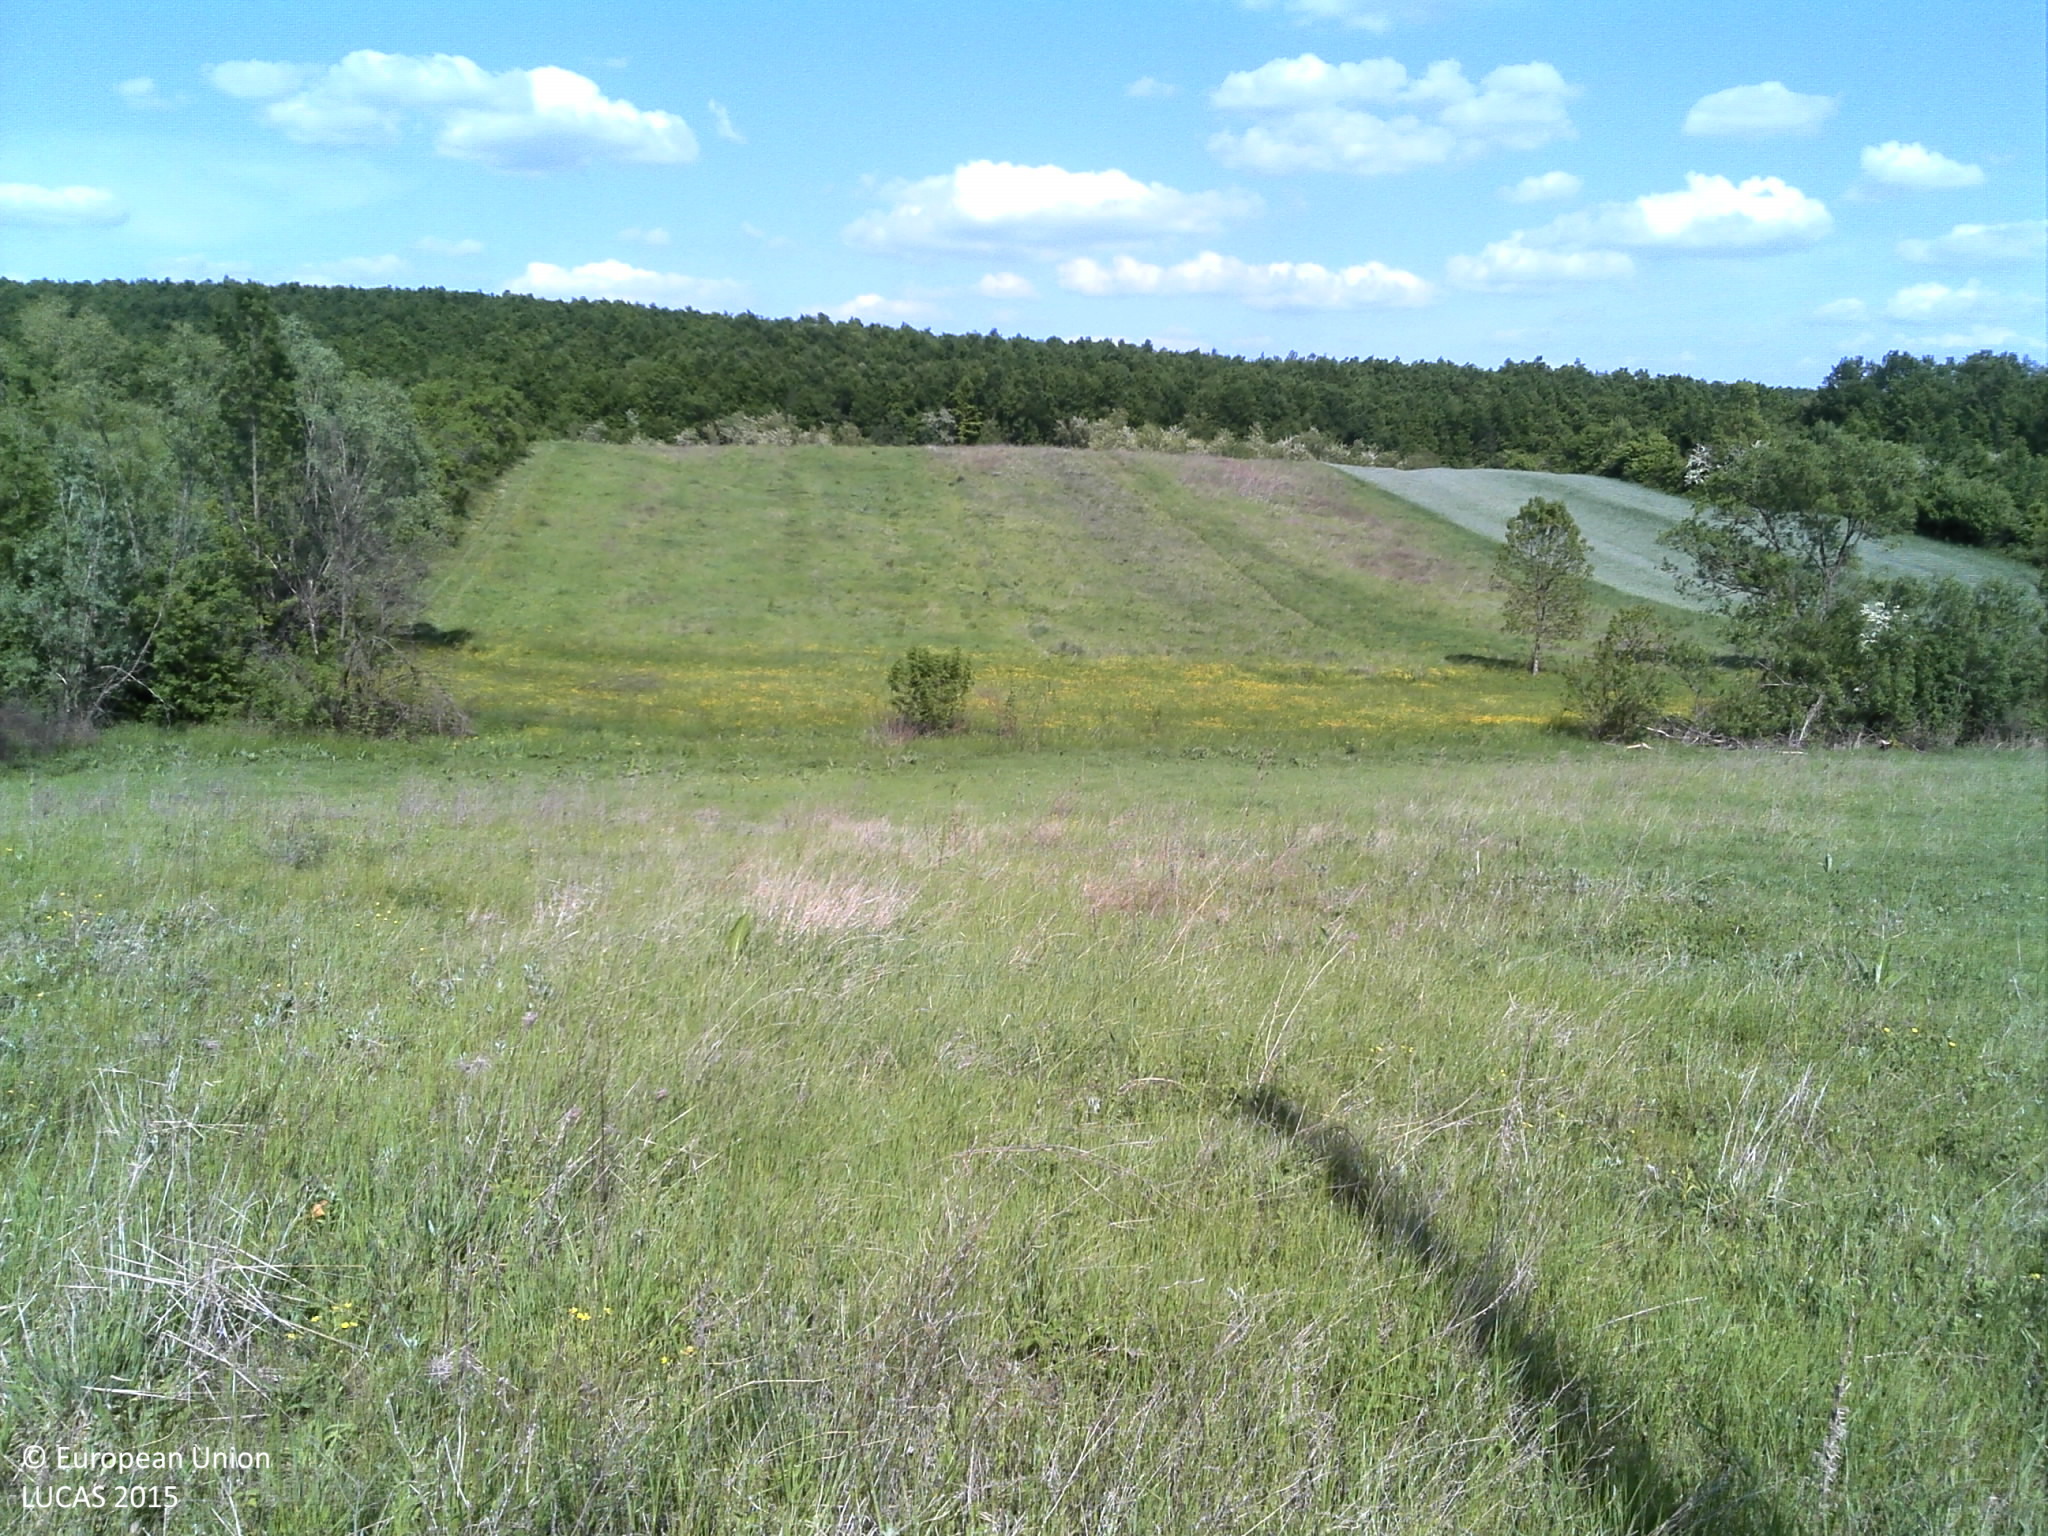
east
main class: Cropland
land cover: Clovers
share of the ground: > 75 %
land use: Agriculture (excluding fallow land and kitchen gardens)
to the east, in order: Clovers; Grass margins; Ditches and canals; Grass margins; Clovers; Grassland without tree/shrub cover; Clovers; Common wheat
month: May
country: HR
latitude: 45.2297
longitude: 18.0910
